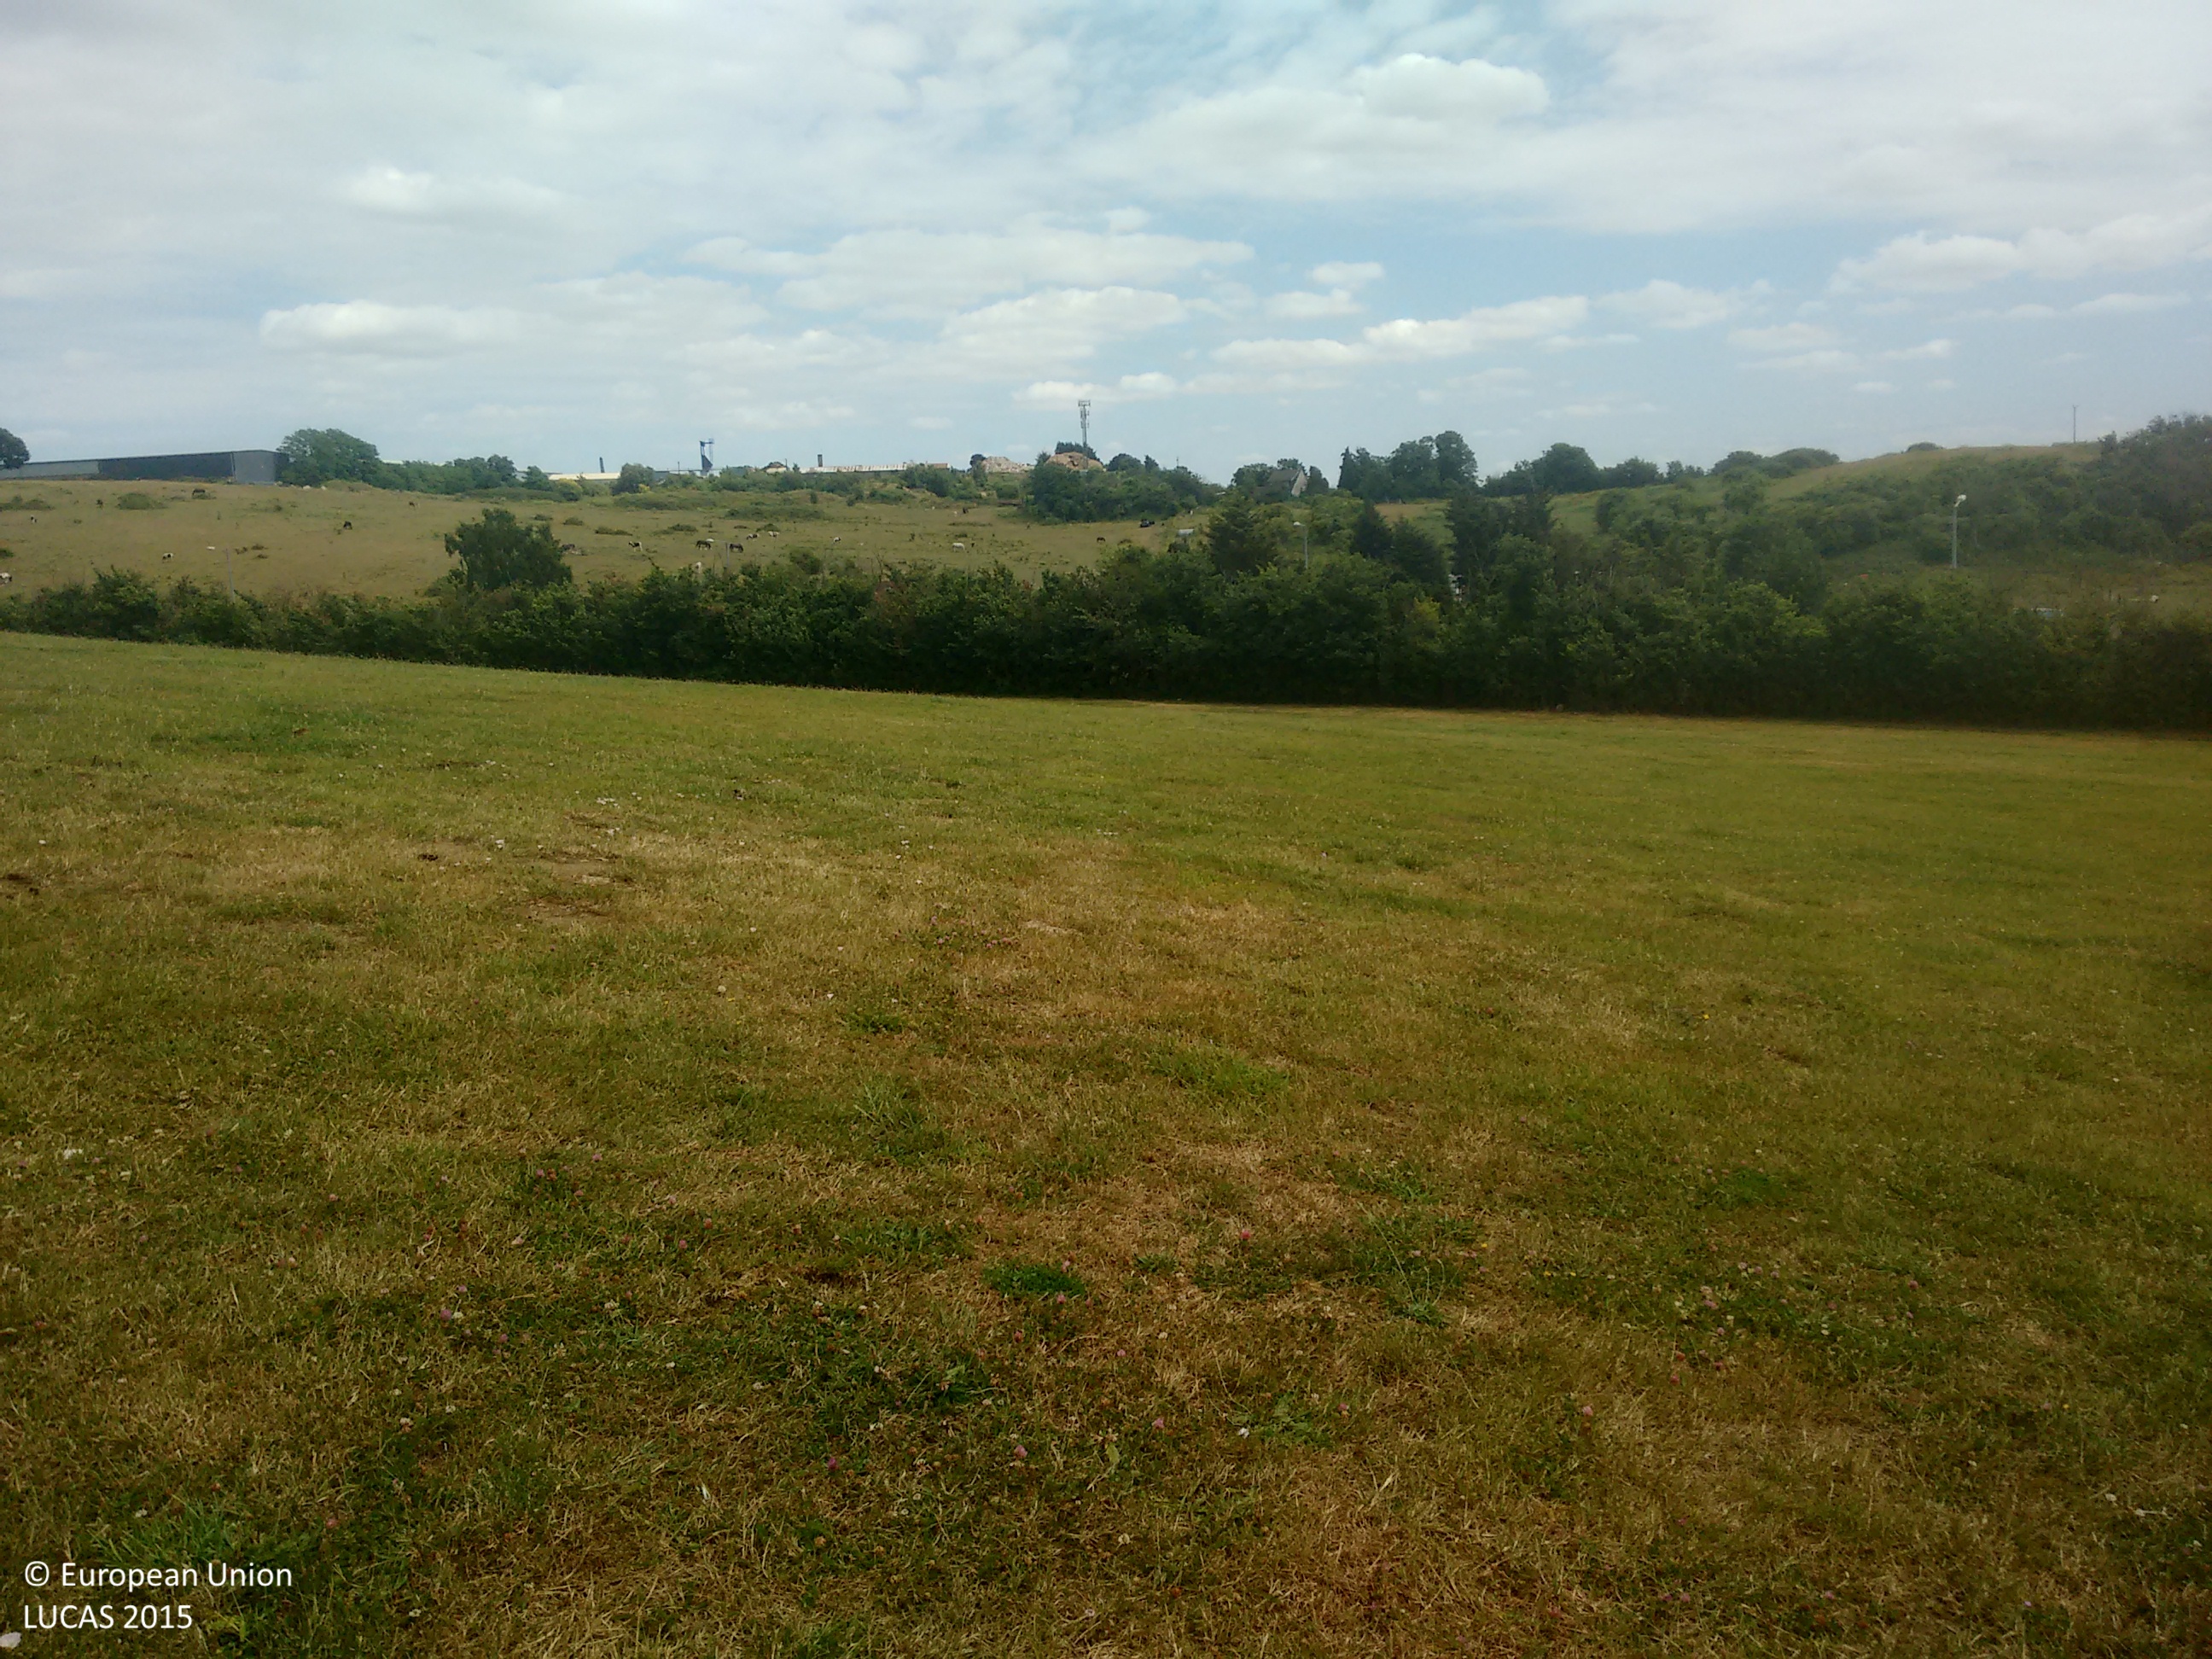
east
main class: Grassland
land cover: Grassland without tree/shrub cover
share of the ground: > 75 %
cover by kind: herbaceous plants 100 %
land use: Community services
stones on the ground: < 10 %
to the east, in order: Grassland without tree/shrub cover; Managed hedges; Artificial constructions in urban areas; Grassland with sparse tree/shrub cover
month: July
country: GB
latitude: 51.4778
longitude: 0.3671
